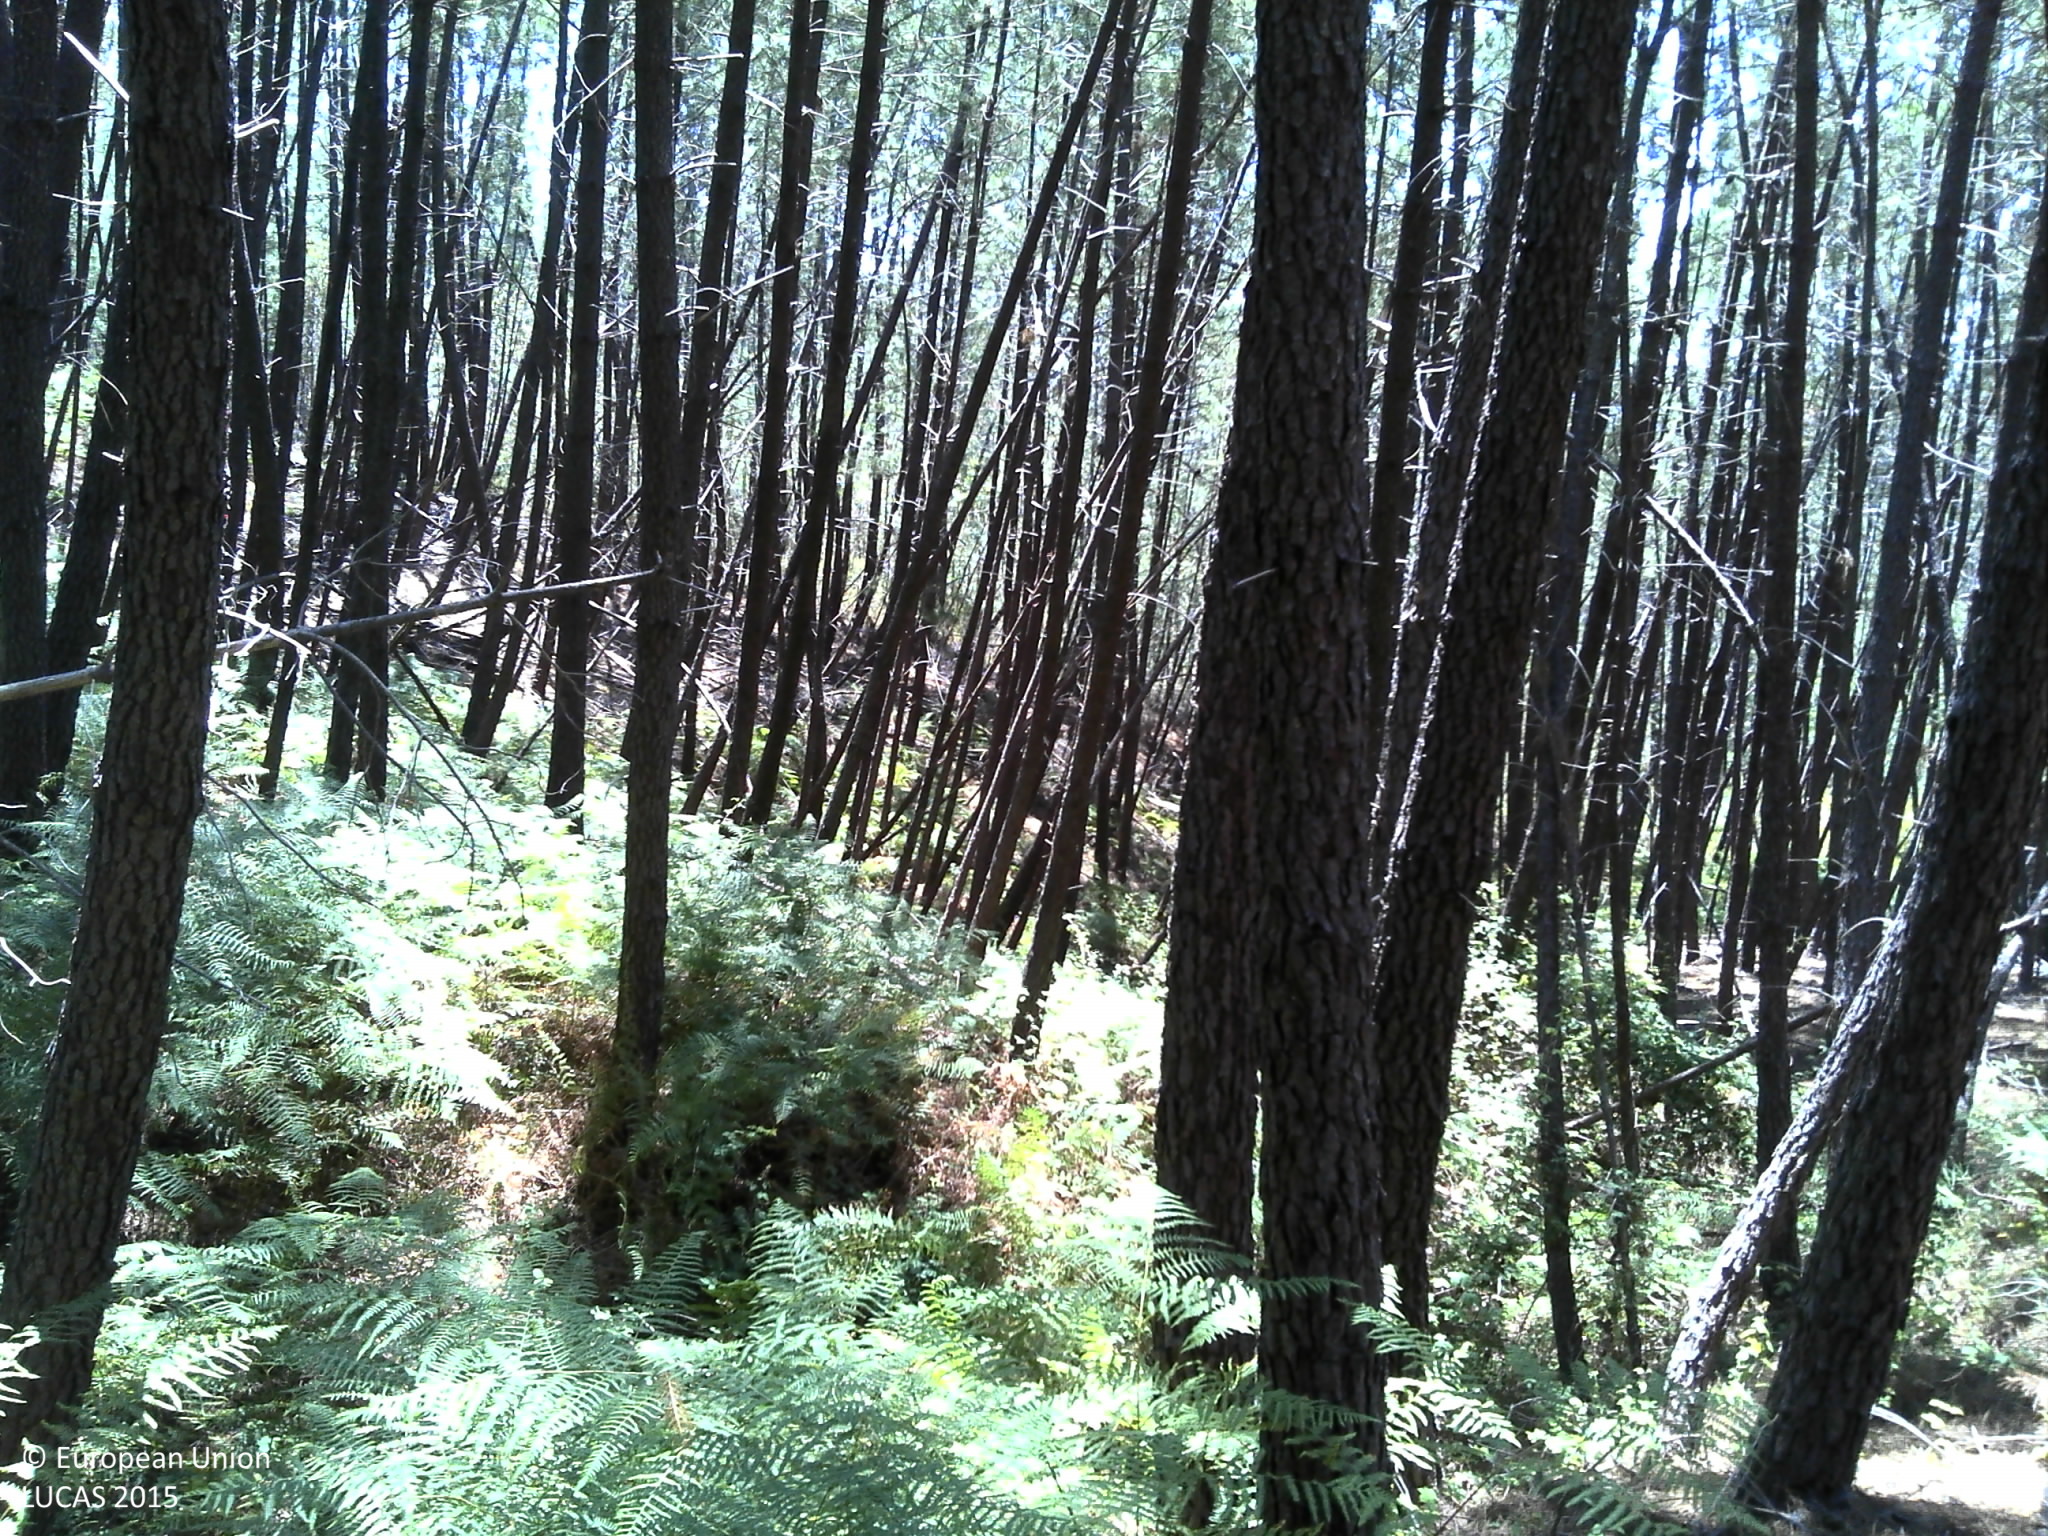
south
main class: Woodland
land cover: Pine dominated coniferous woodland
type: coniferous forest of the mediterranean region
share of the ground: 10 - 25 %
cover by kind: unconsolidated bare surface 55 %, shrubs 30 %, coniferous forest trees 15 %
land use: Forestry
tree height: > 5 m
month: July
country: PT
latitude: 39.9967
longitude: -8.1688
